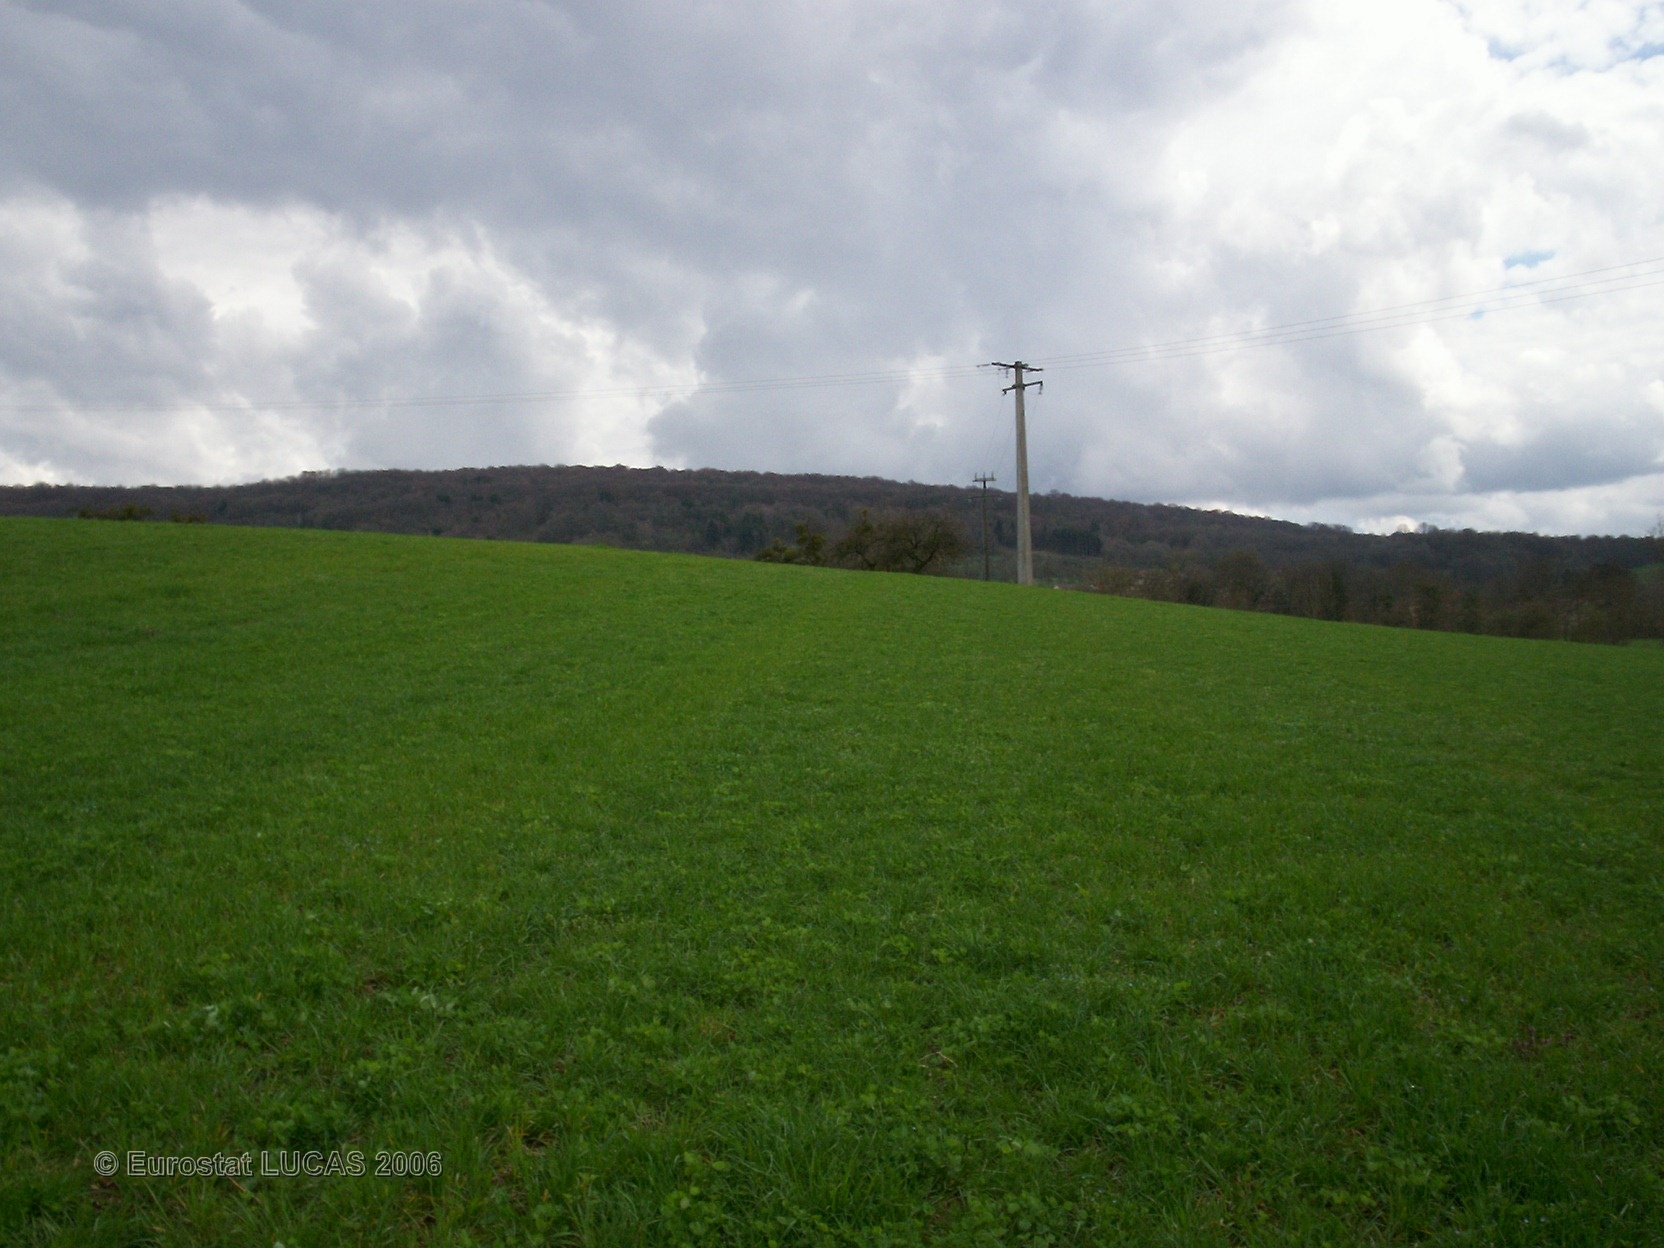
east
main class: Cropland
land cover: Other leguminous and mixtures for fodder
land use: Agriculture (excluding fallow land and kitchen gardens)
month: April
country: FR
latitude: 47.5206
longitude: 6.5354
